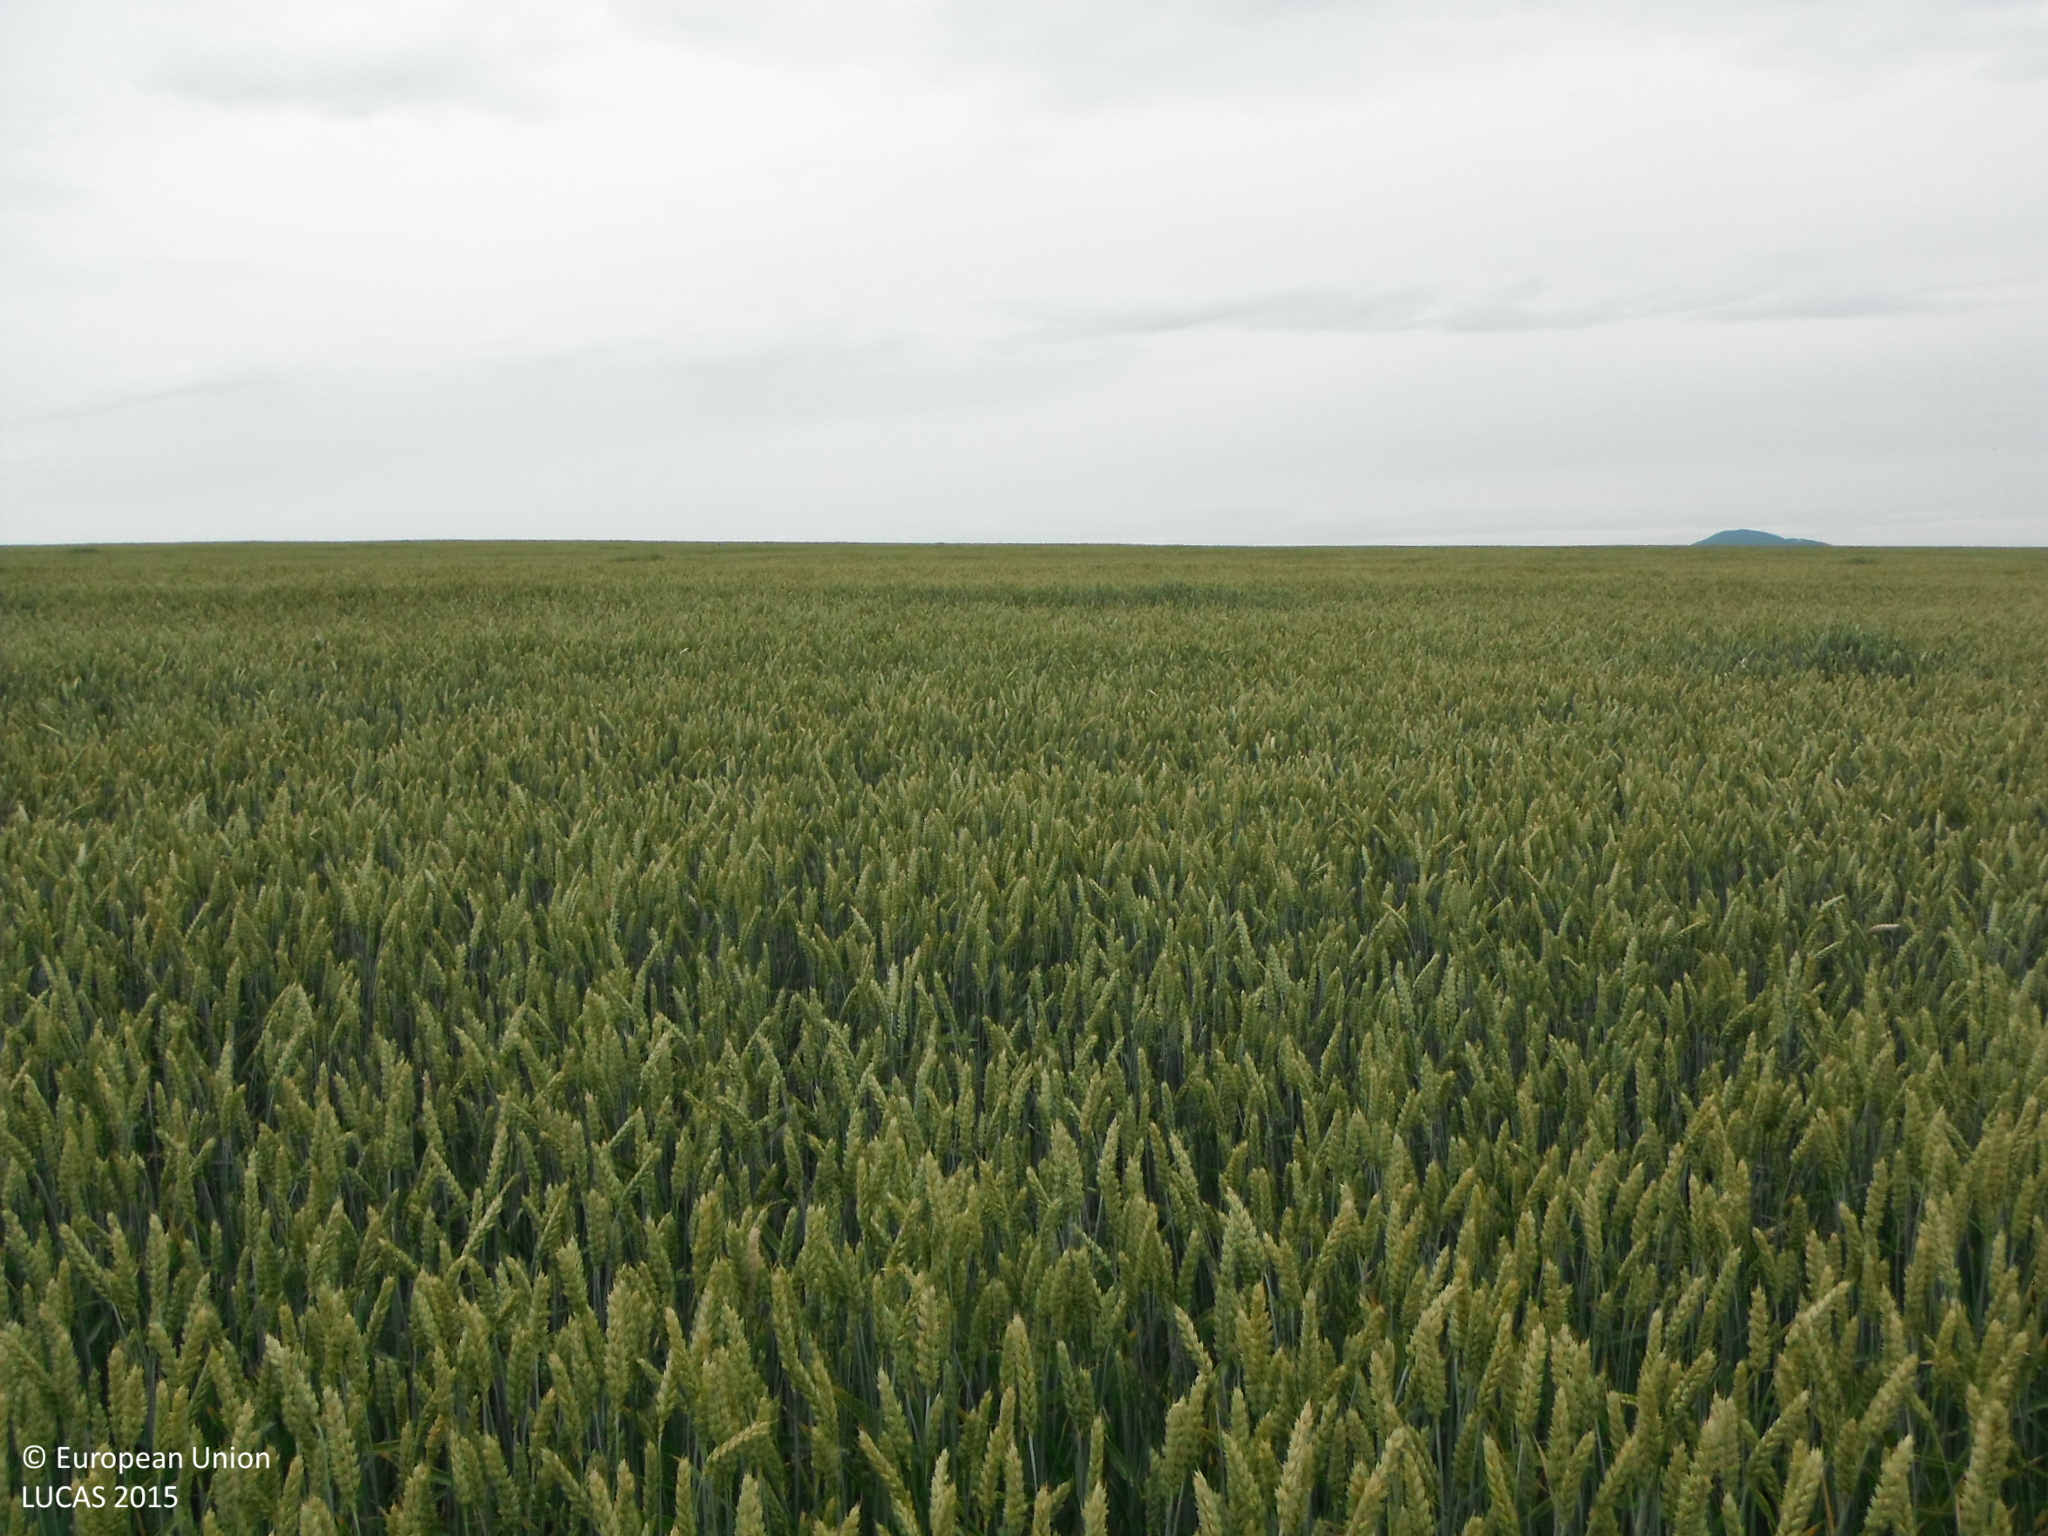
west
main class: Cropland
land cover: Common wheat
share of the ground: > 75 %
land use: Agriculture (excluding fallow land and kitchen gardens)
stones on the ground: < 10 %
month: June
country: SK
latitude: 48.3096
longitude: 18.2801
